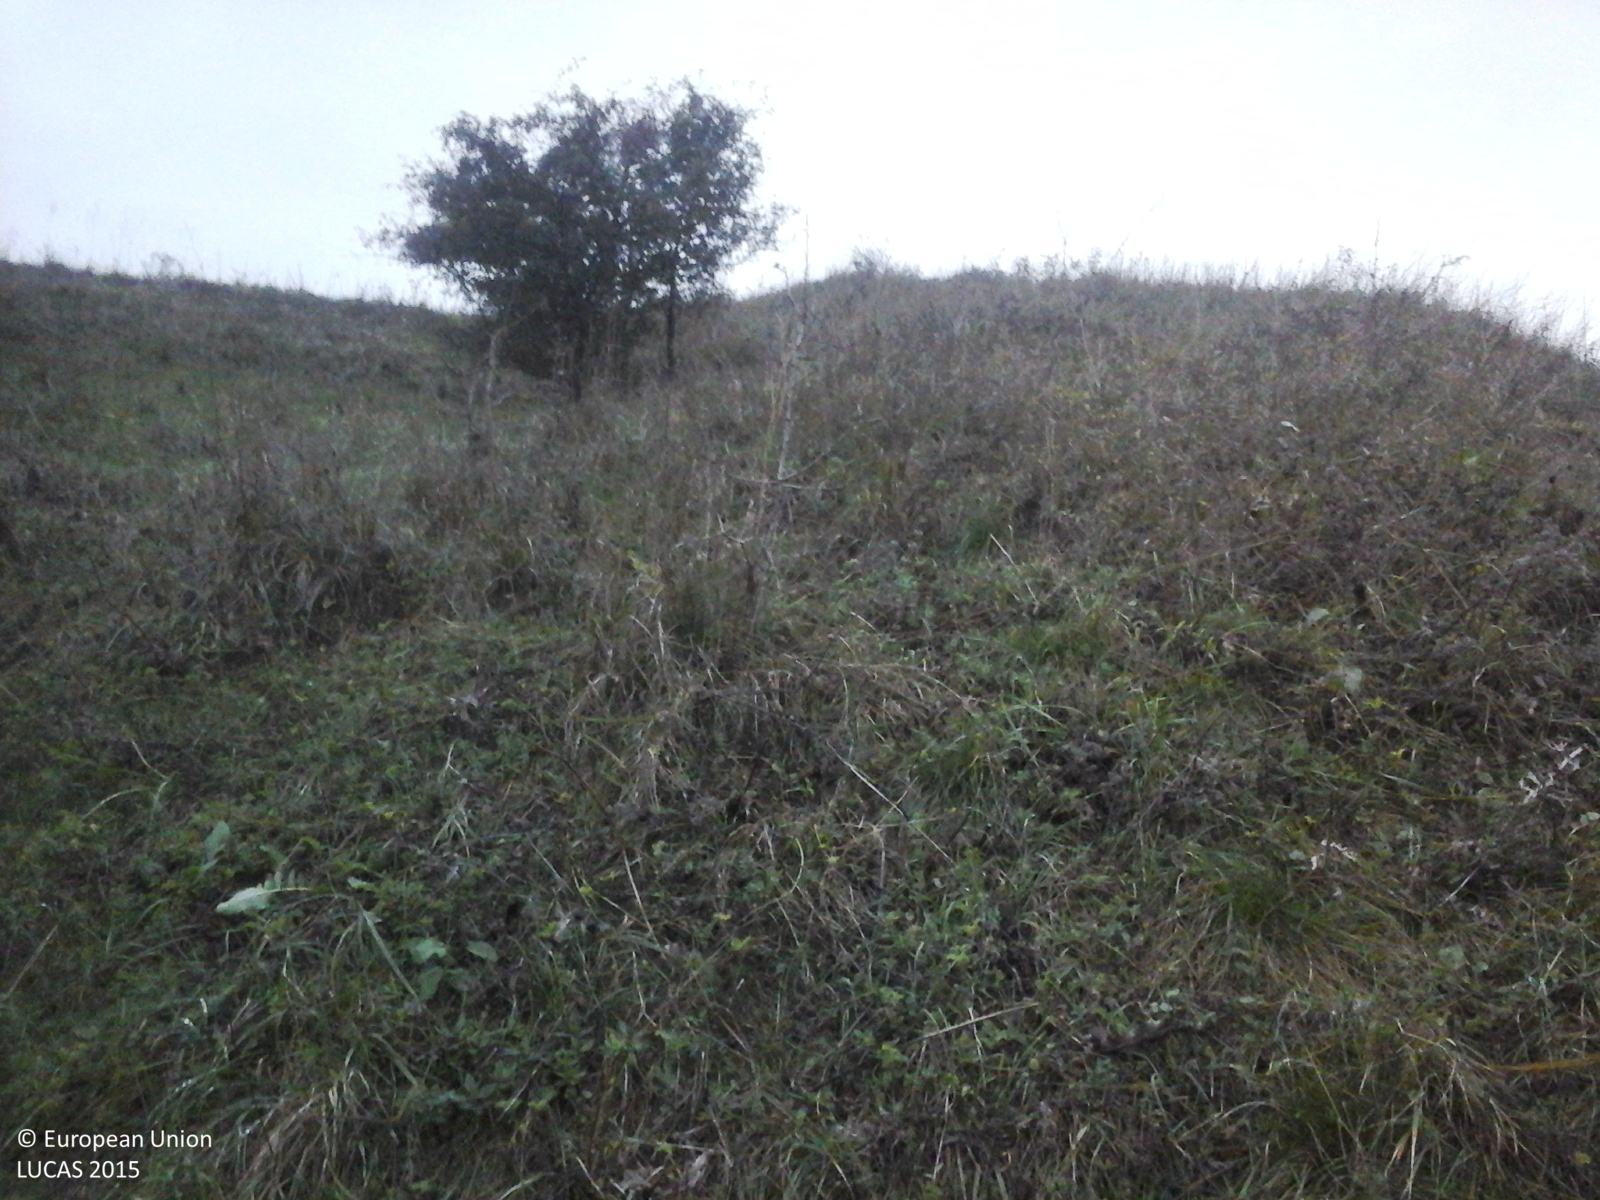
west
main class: Grassland
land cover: Grassland with sparse tree/shrub cover
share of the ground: > 75 %
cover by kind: herbaceous plants 85 %, shrubs 10 %, broadleaved forest trees 5 %
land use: Agriculture (excluding fallow land and kitchen gardens)
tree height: > 5 m
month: October
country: RO
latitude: 45.9175
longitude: 24.1422
